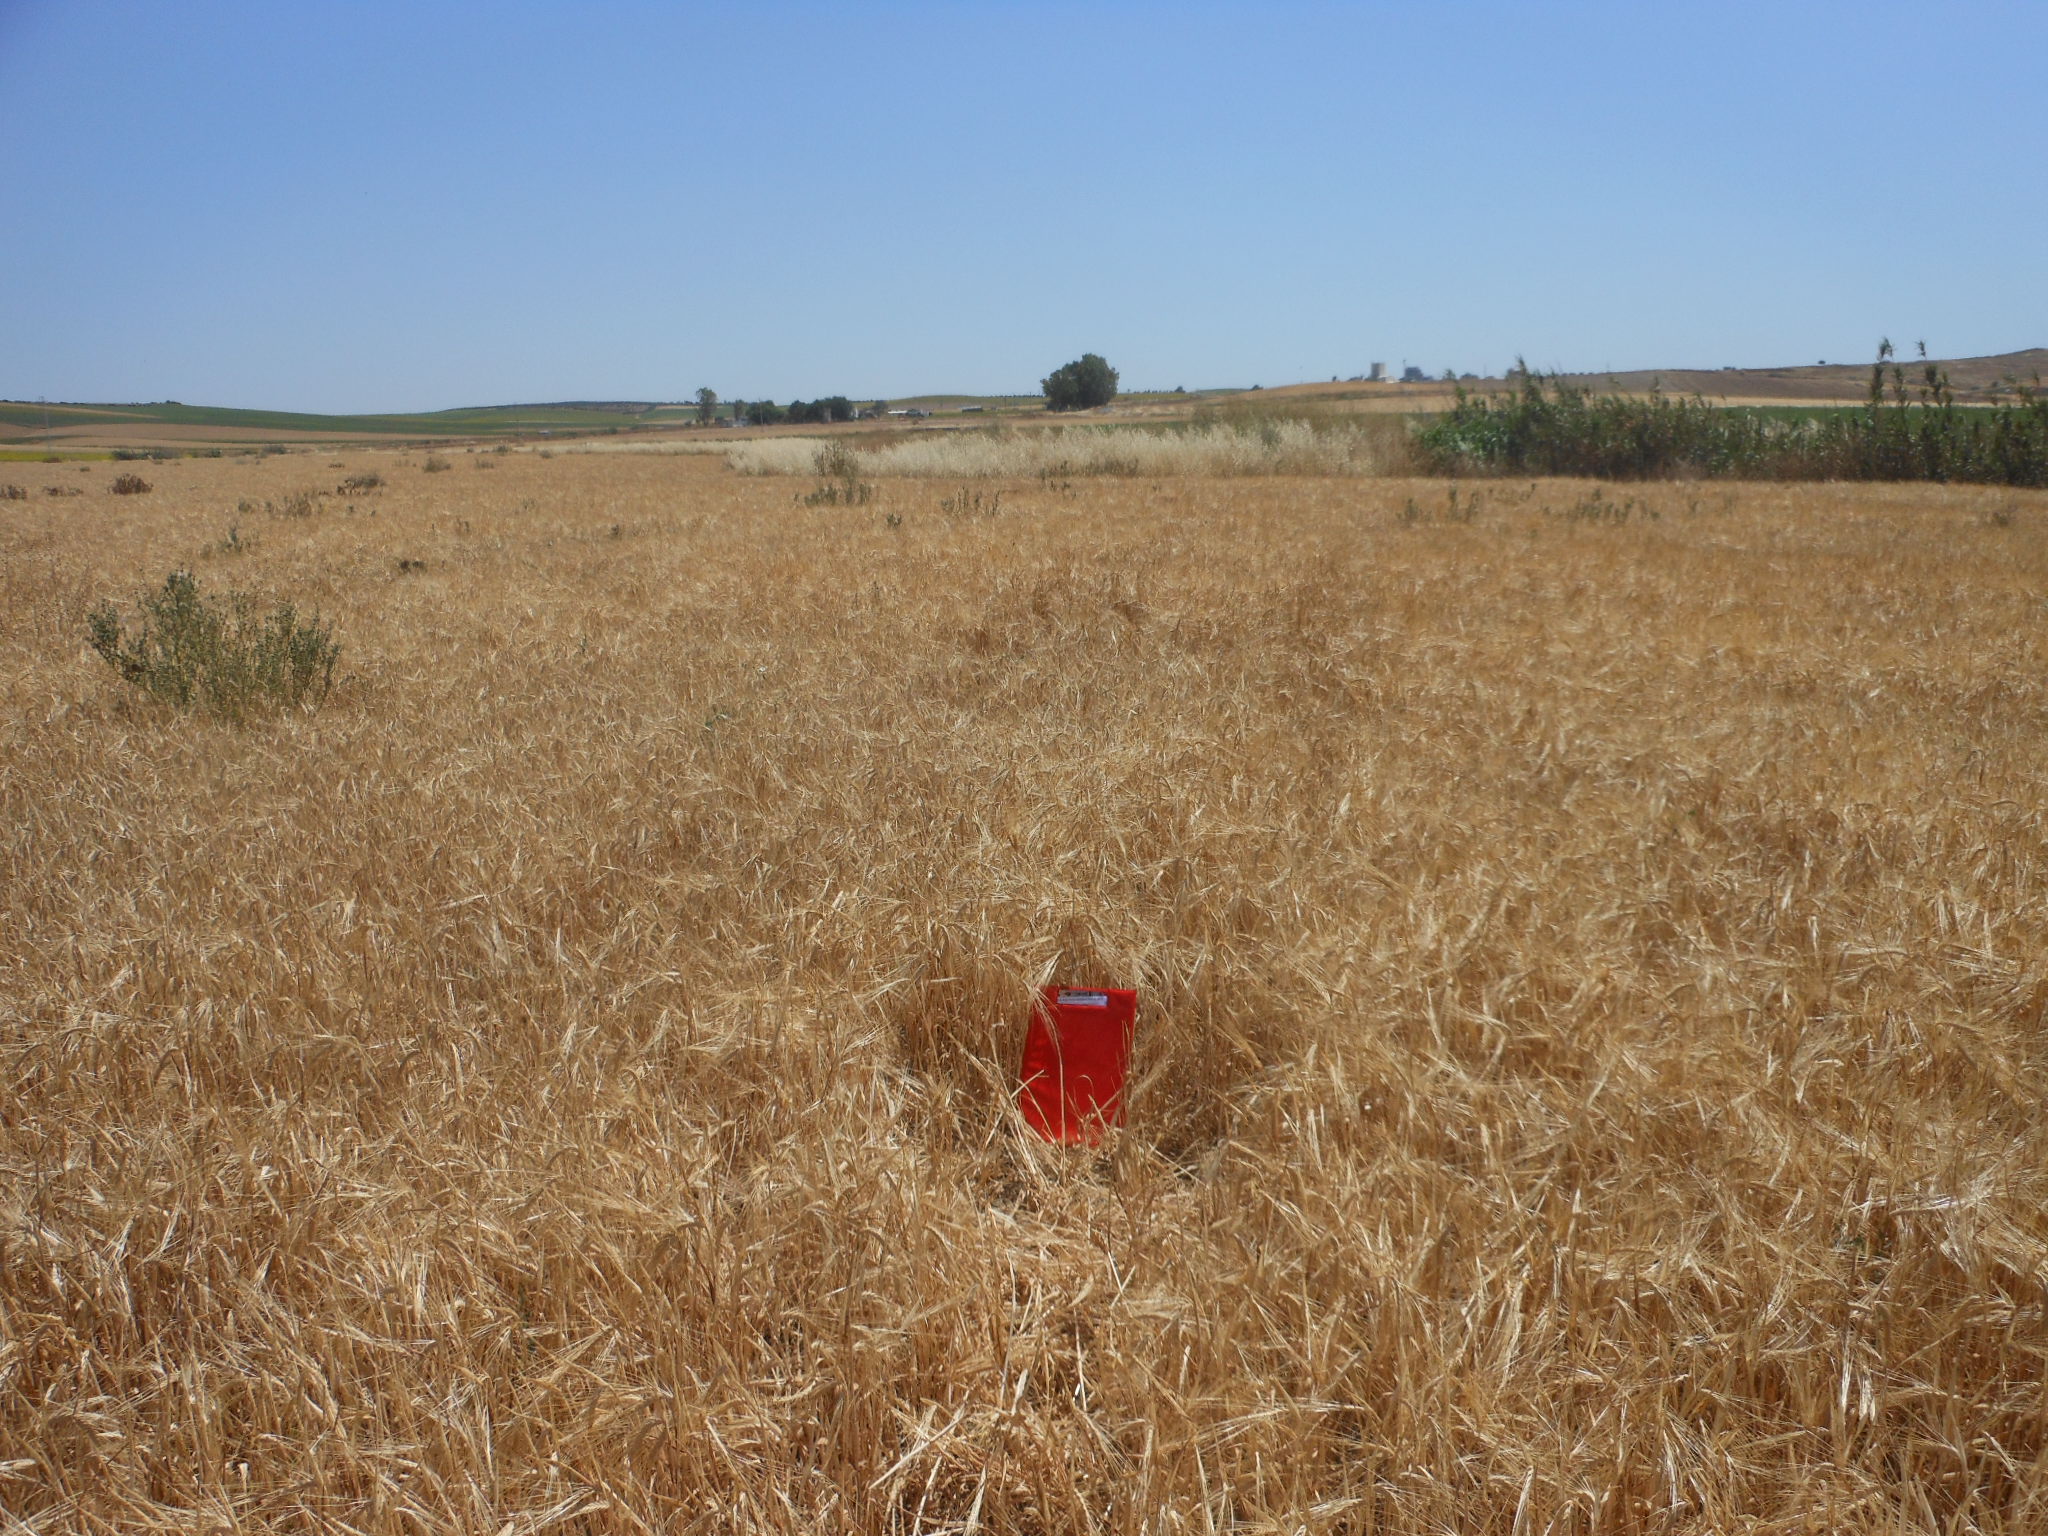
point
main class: Cropland
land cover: Barley
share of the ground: > 75 %
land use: Agriculture (excluding fallow land and kitchen gardens)
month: May
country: ES
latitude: 37.4606
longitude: -5.4027
